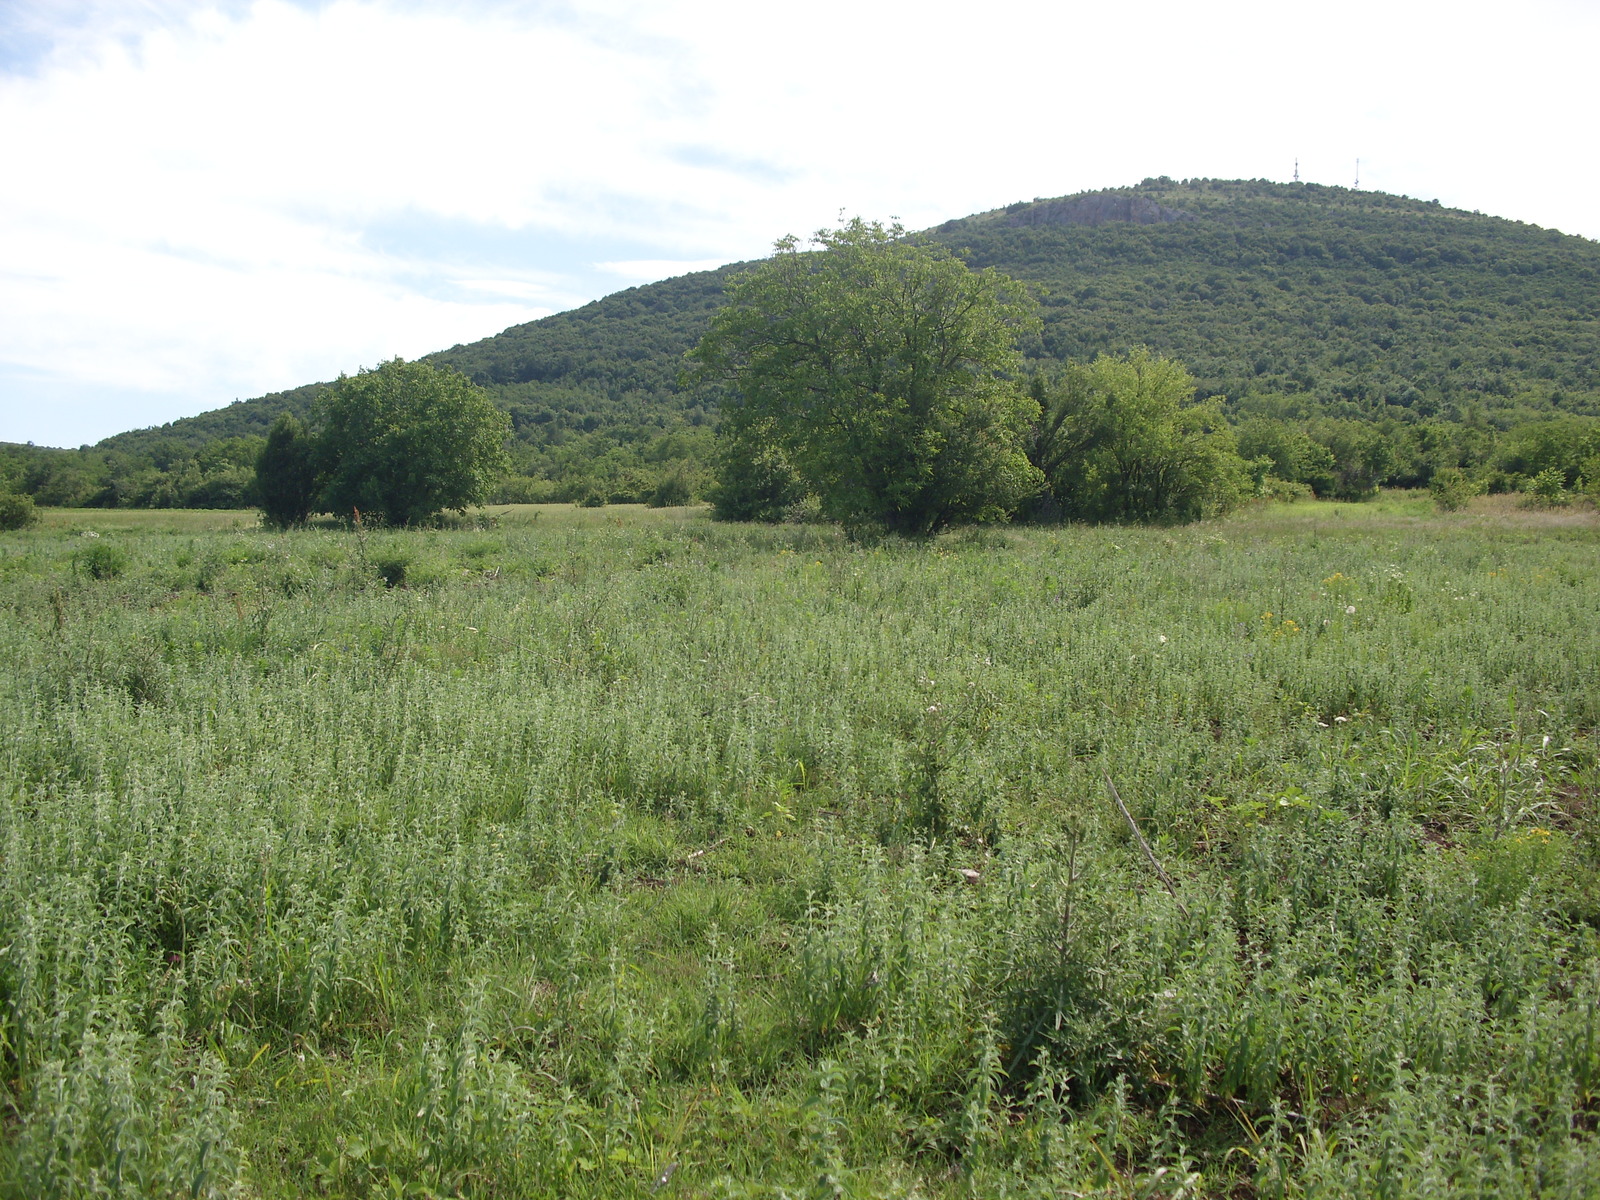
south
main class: Grassland
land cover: Spontaneously vegetated surfaces
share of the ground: 25 - 50 %
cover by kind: unconsolidated bare surface 55 %, herbaceous plants 45 %
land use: Fallow land
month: June
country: BG
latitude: 43.4401
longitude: 23.1226
